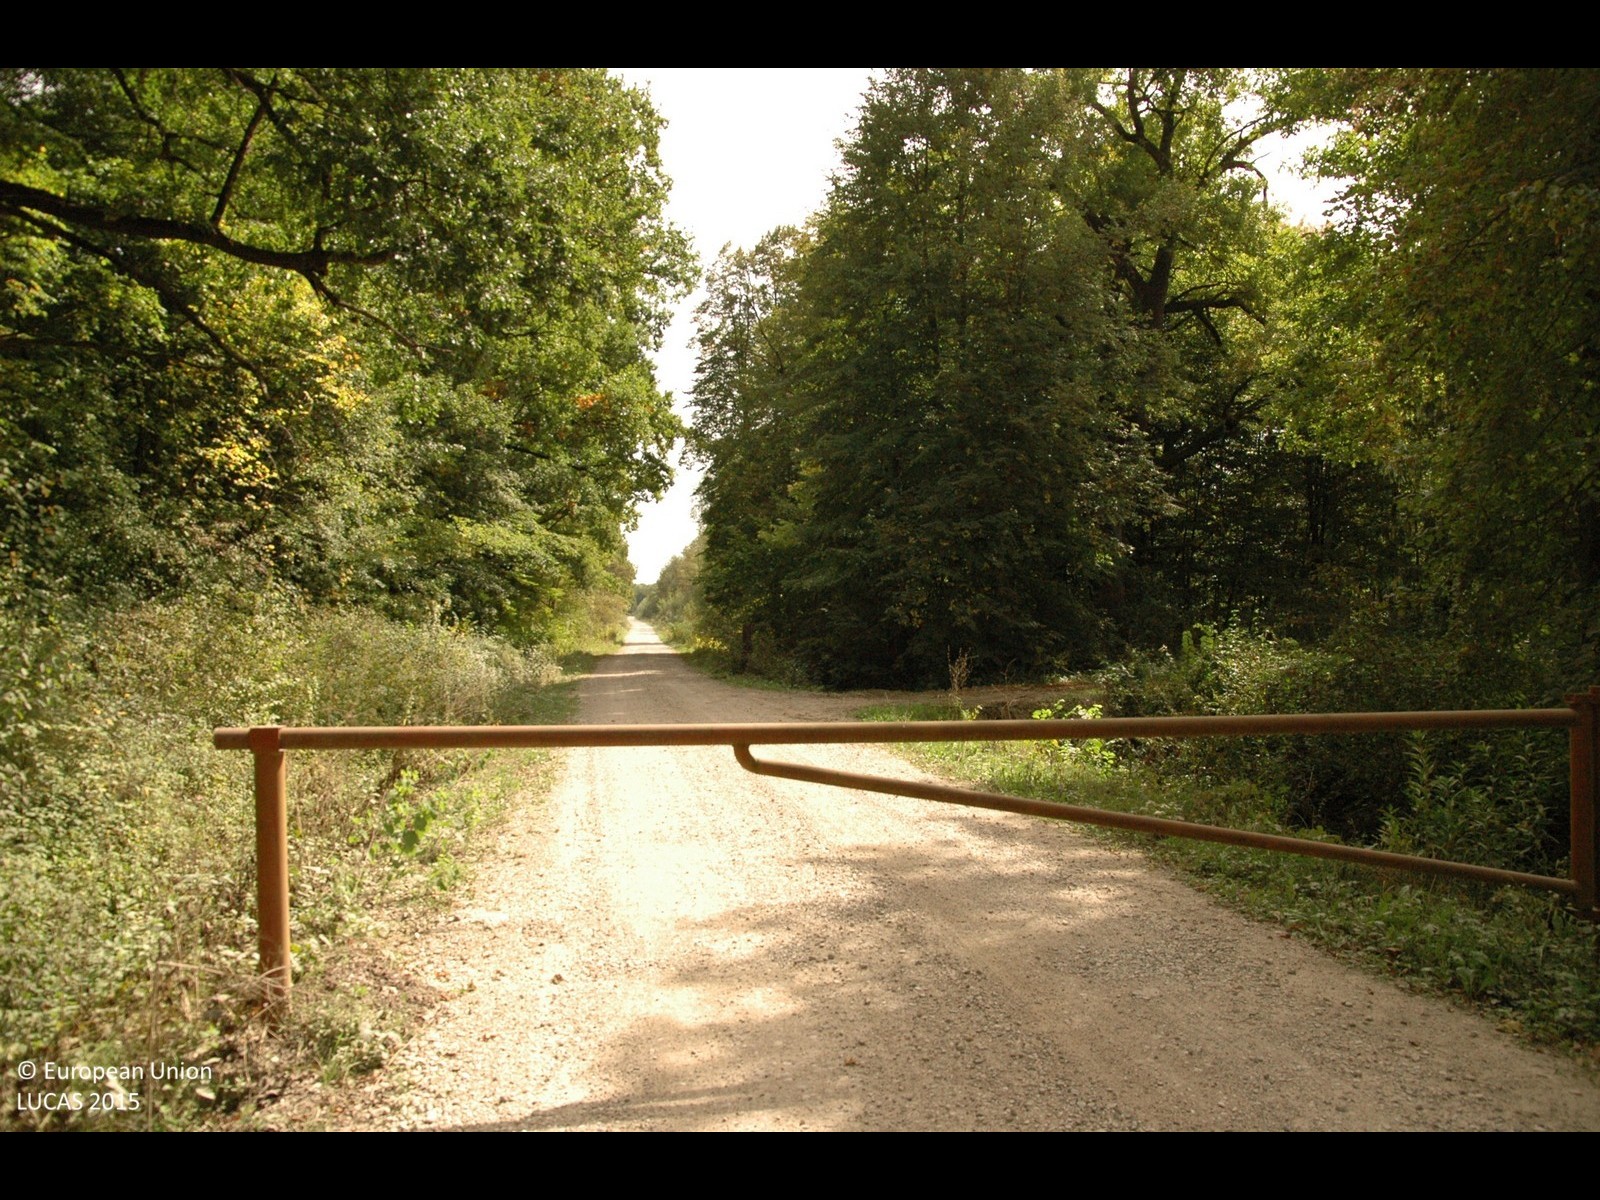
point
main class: Woodland
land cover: Broadleaved woodland
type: mesophytic deciduous forest
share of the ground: > 75 %
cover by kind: broadleaved forest trees 100 %
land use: Forestry
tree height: > 5 m
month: September
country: HR
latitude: 45.6282
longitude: 16.2189
